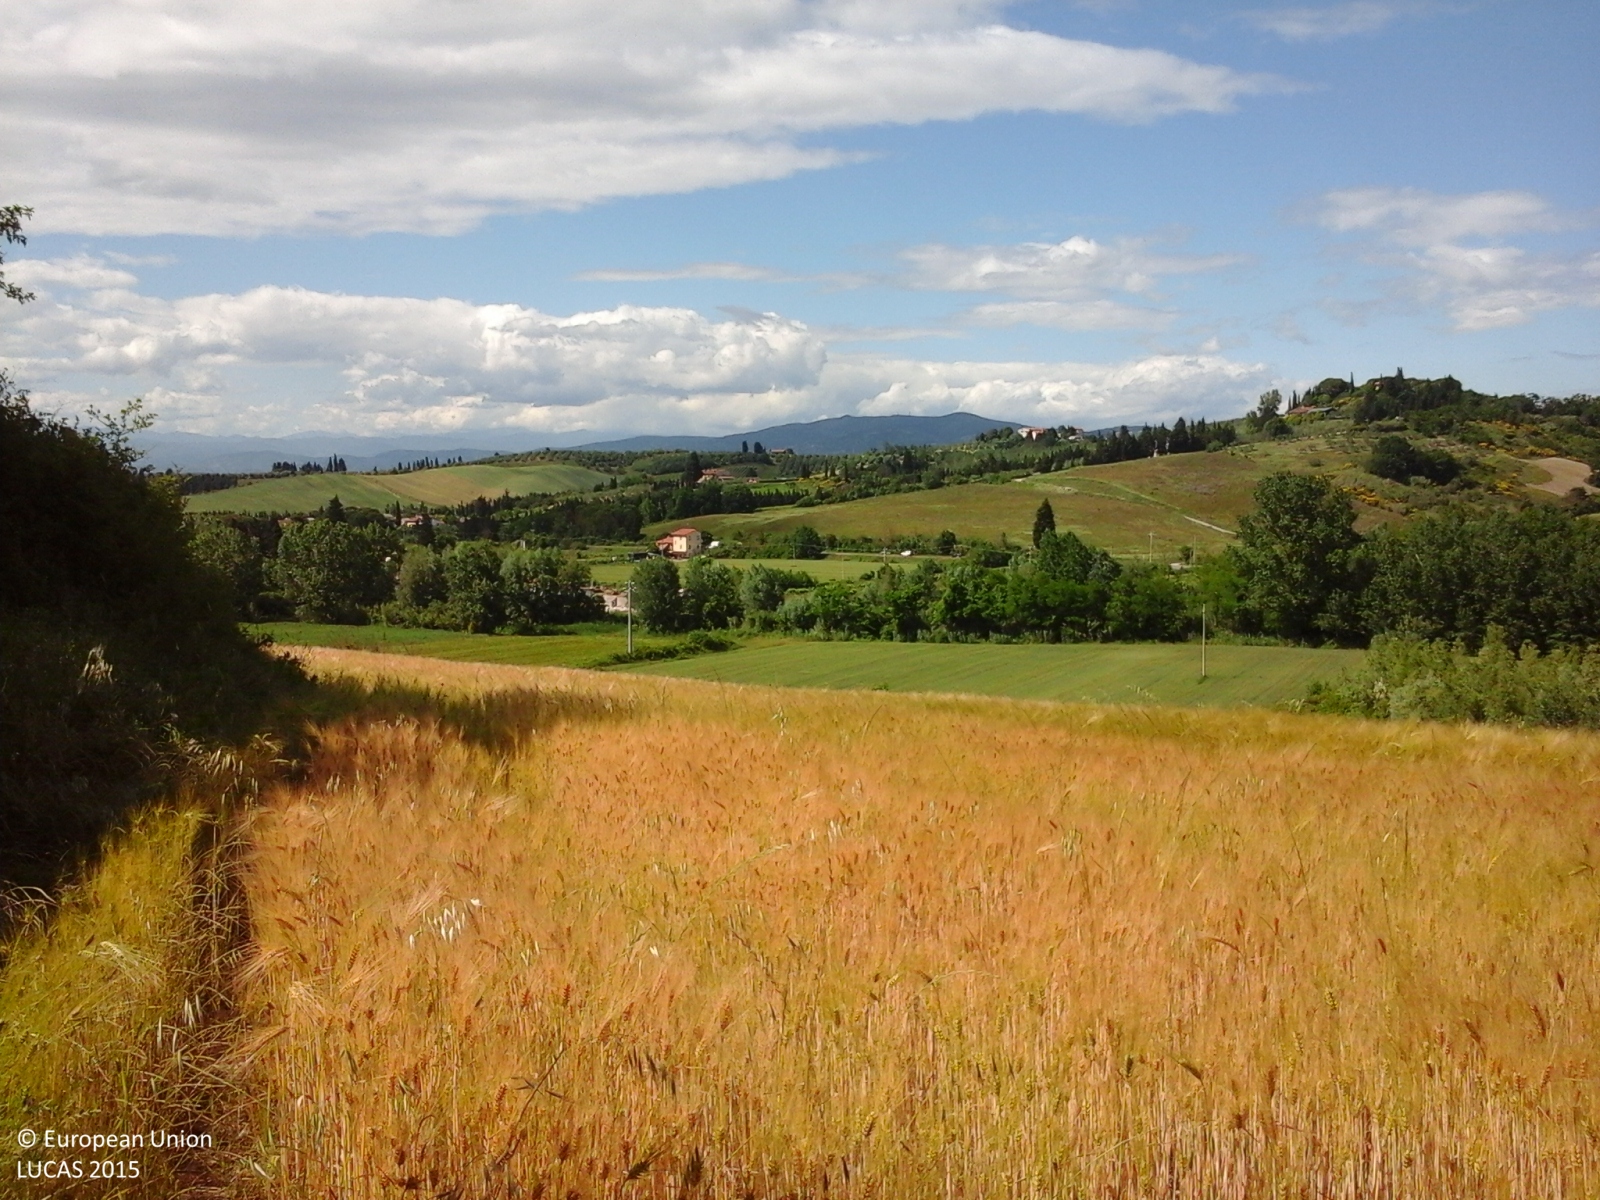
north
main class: Cropland
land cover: Durum wheat
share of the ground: > 75 %
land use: Agriculture (excluding fallow land and kitchen gardens)
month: May
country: IT
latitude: 43.6784
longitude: 10.9773
